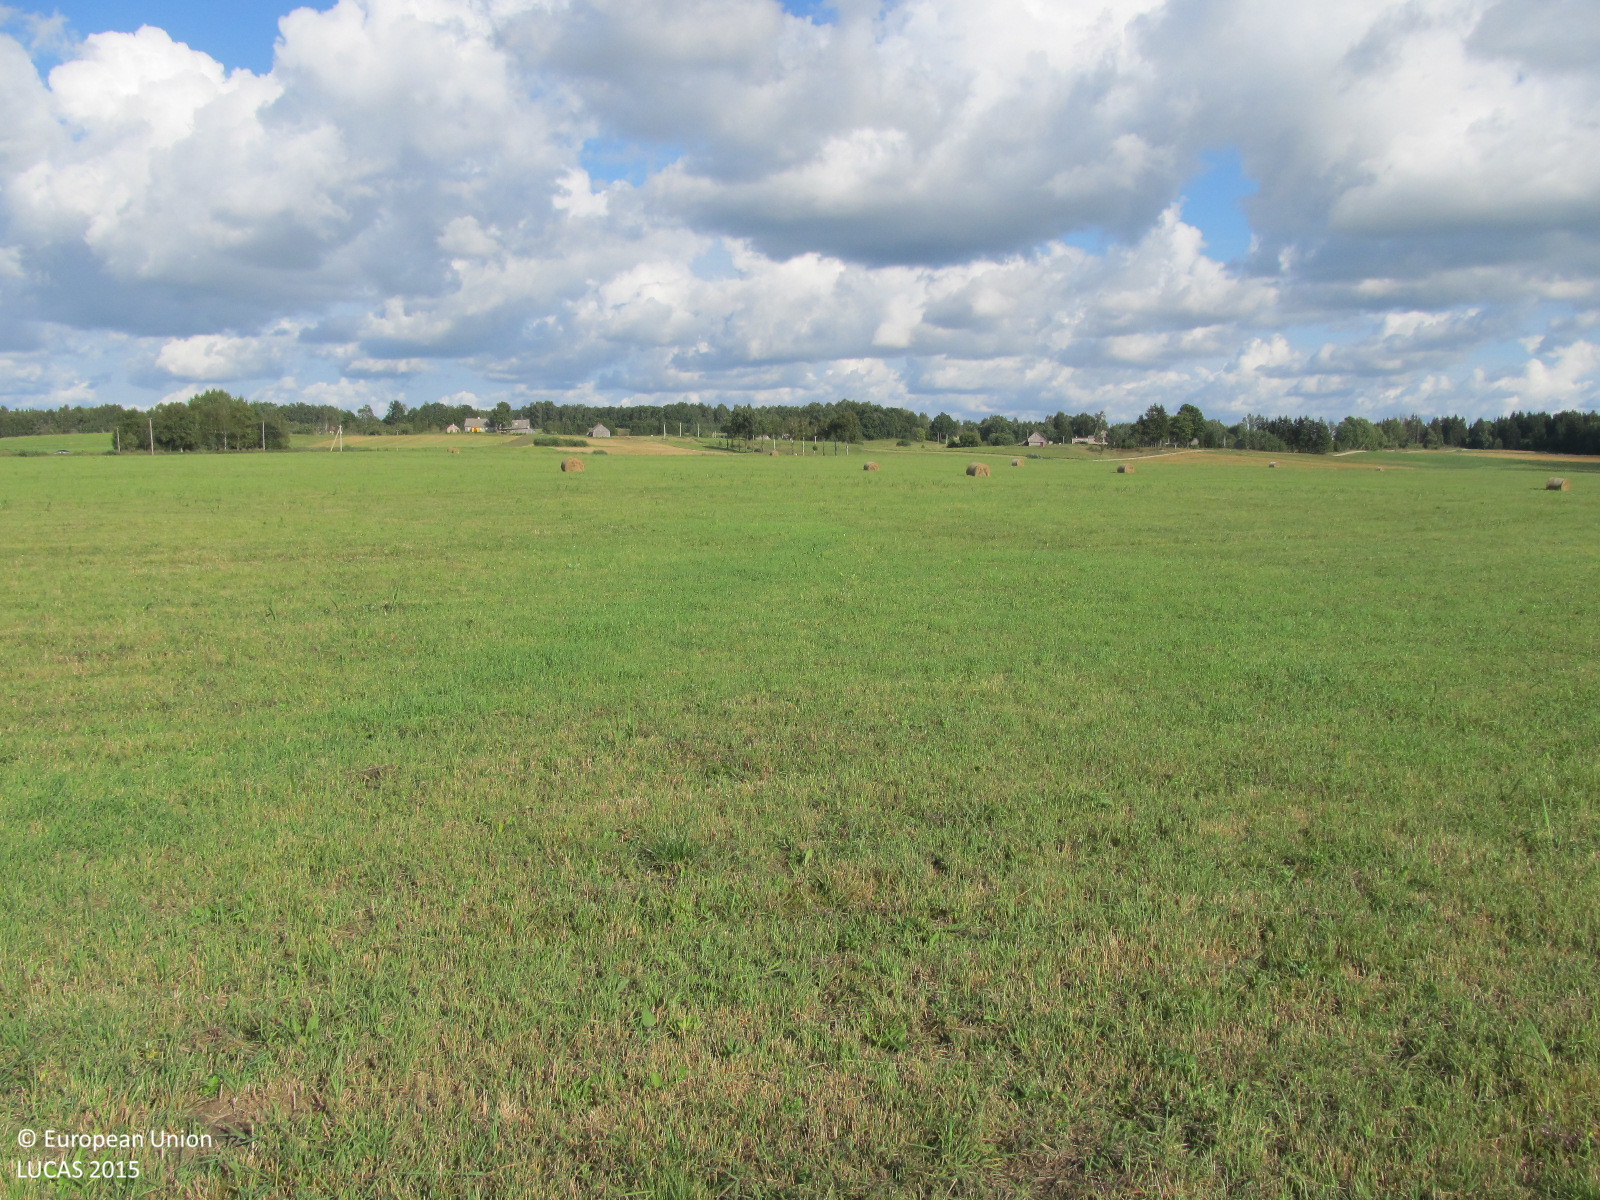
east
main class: Grassland
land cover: Grassland without tree/shrub cover
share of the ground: > 75 %
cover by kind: herbaceous plants 100 %
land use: Agriculture (excluding fallow land and kitchen gardens)
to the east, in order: Grassland without tree/shrub cover
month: September
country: LT
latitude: 55.6690
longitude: 22.6388
